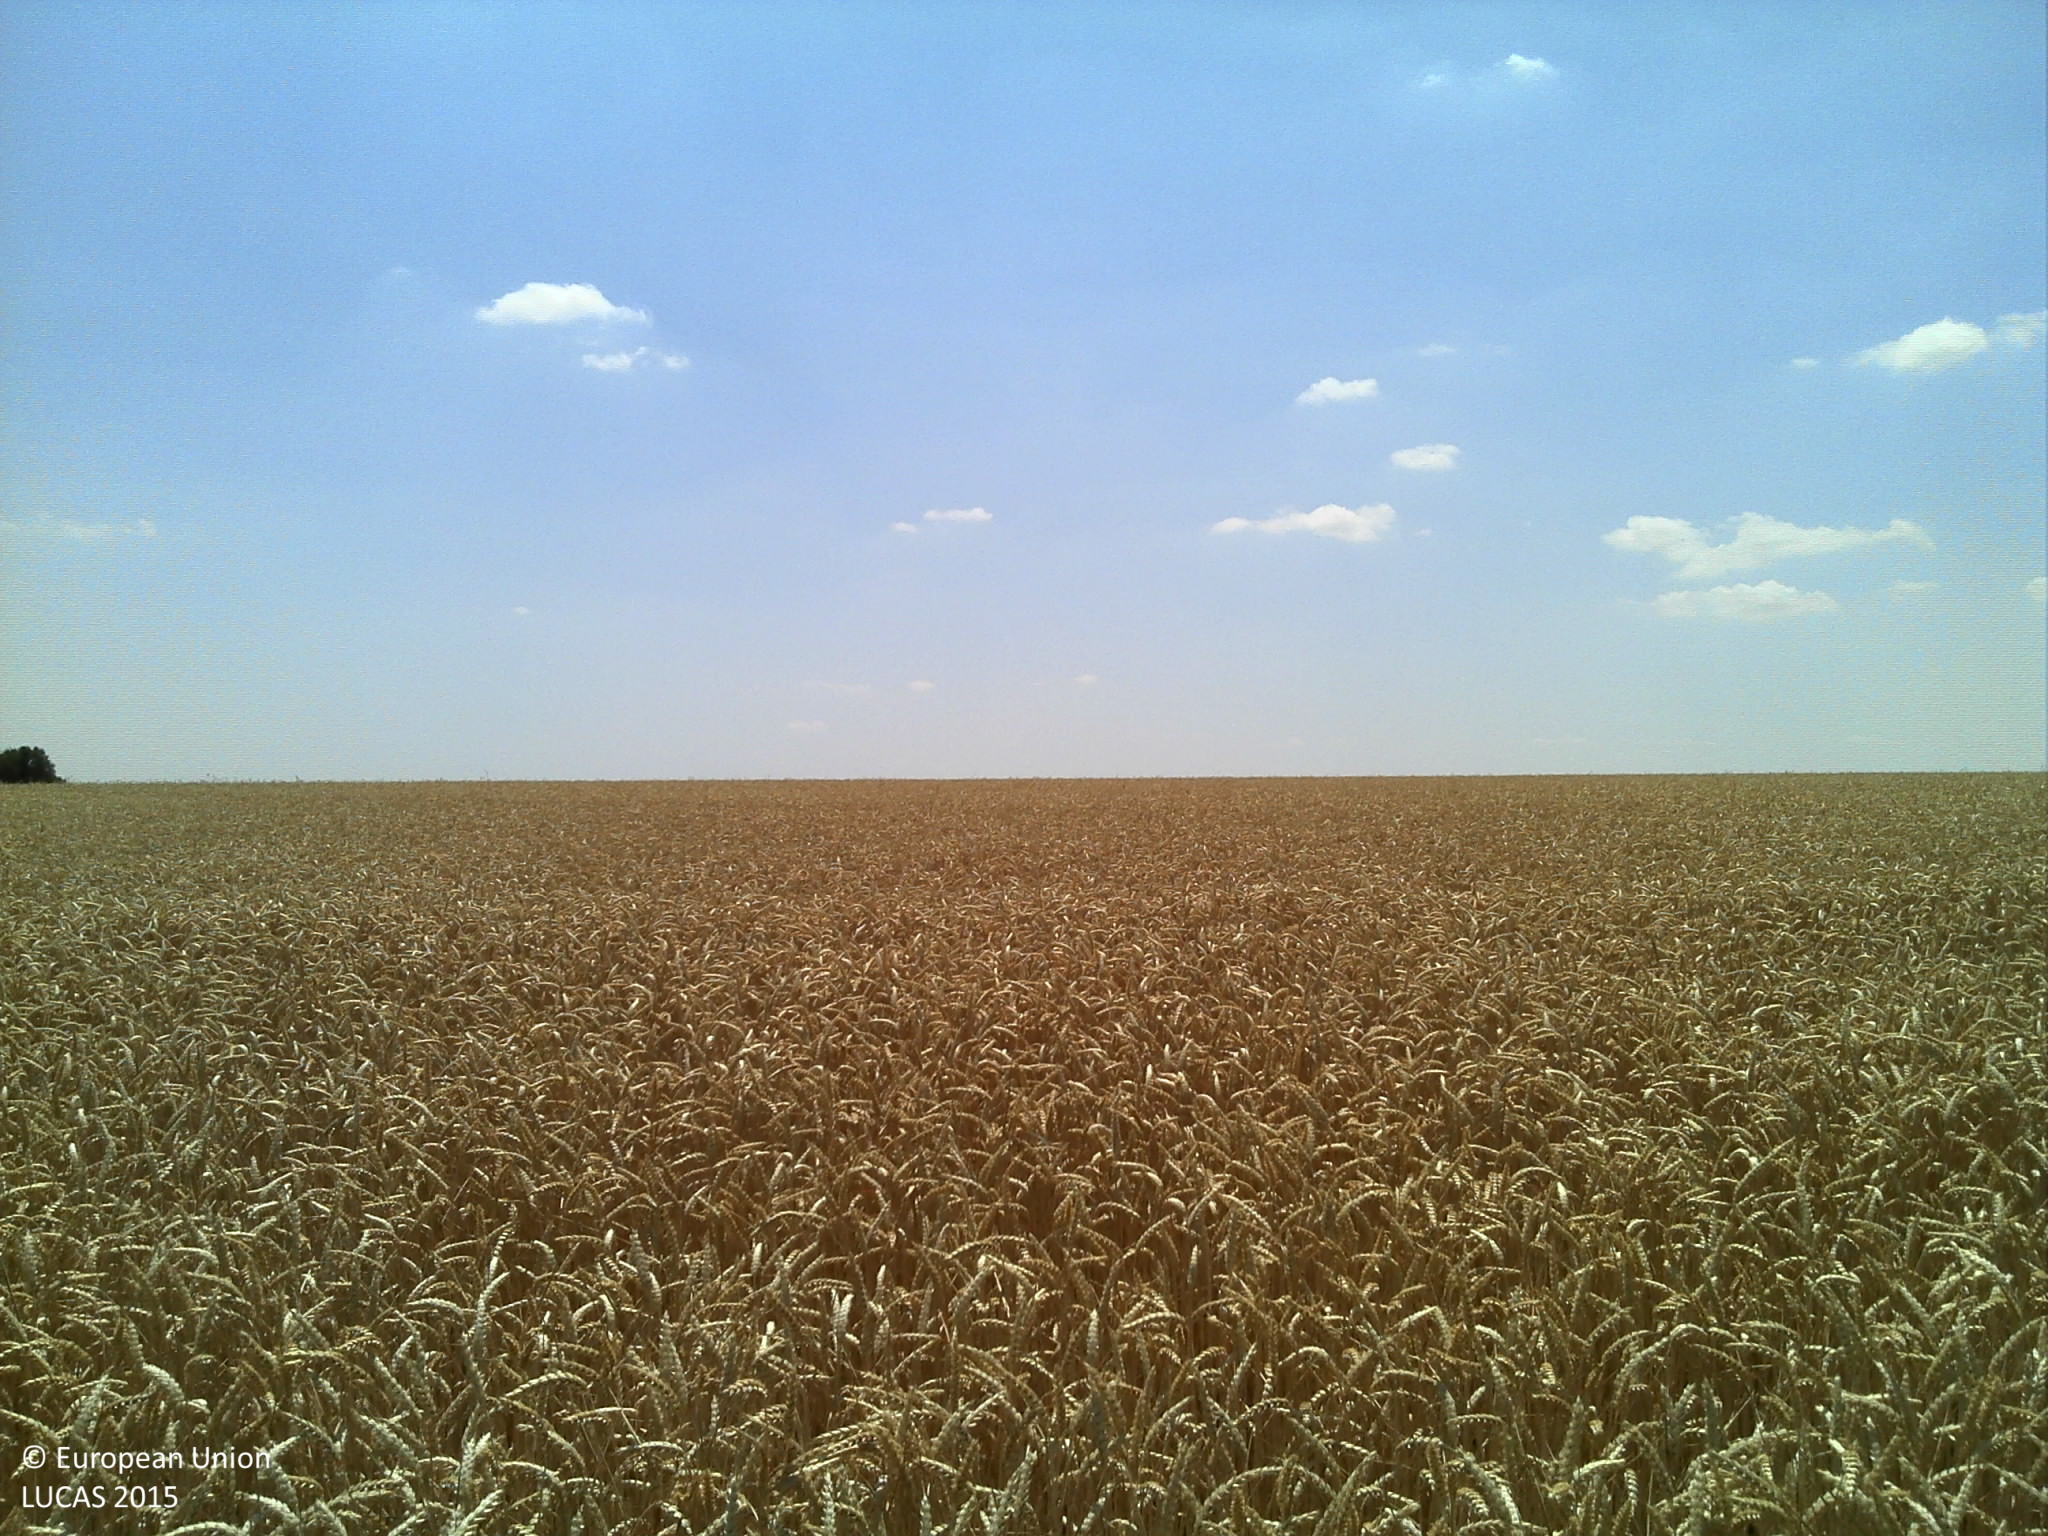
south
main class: Cropland
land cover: Common wheat
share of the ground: > 75 %
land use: Agriculture (excluding fallow land and kitchen gardens)
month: July
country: FR
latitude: 48.4903
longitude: 1.9623
